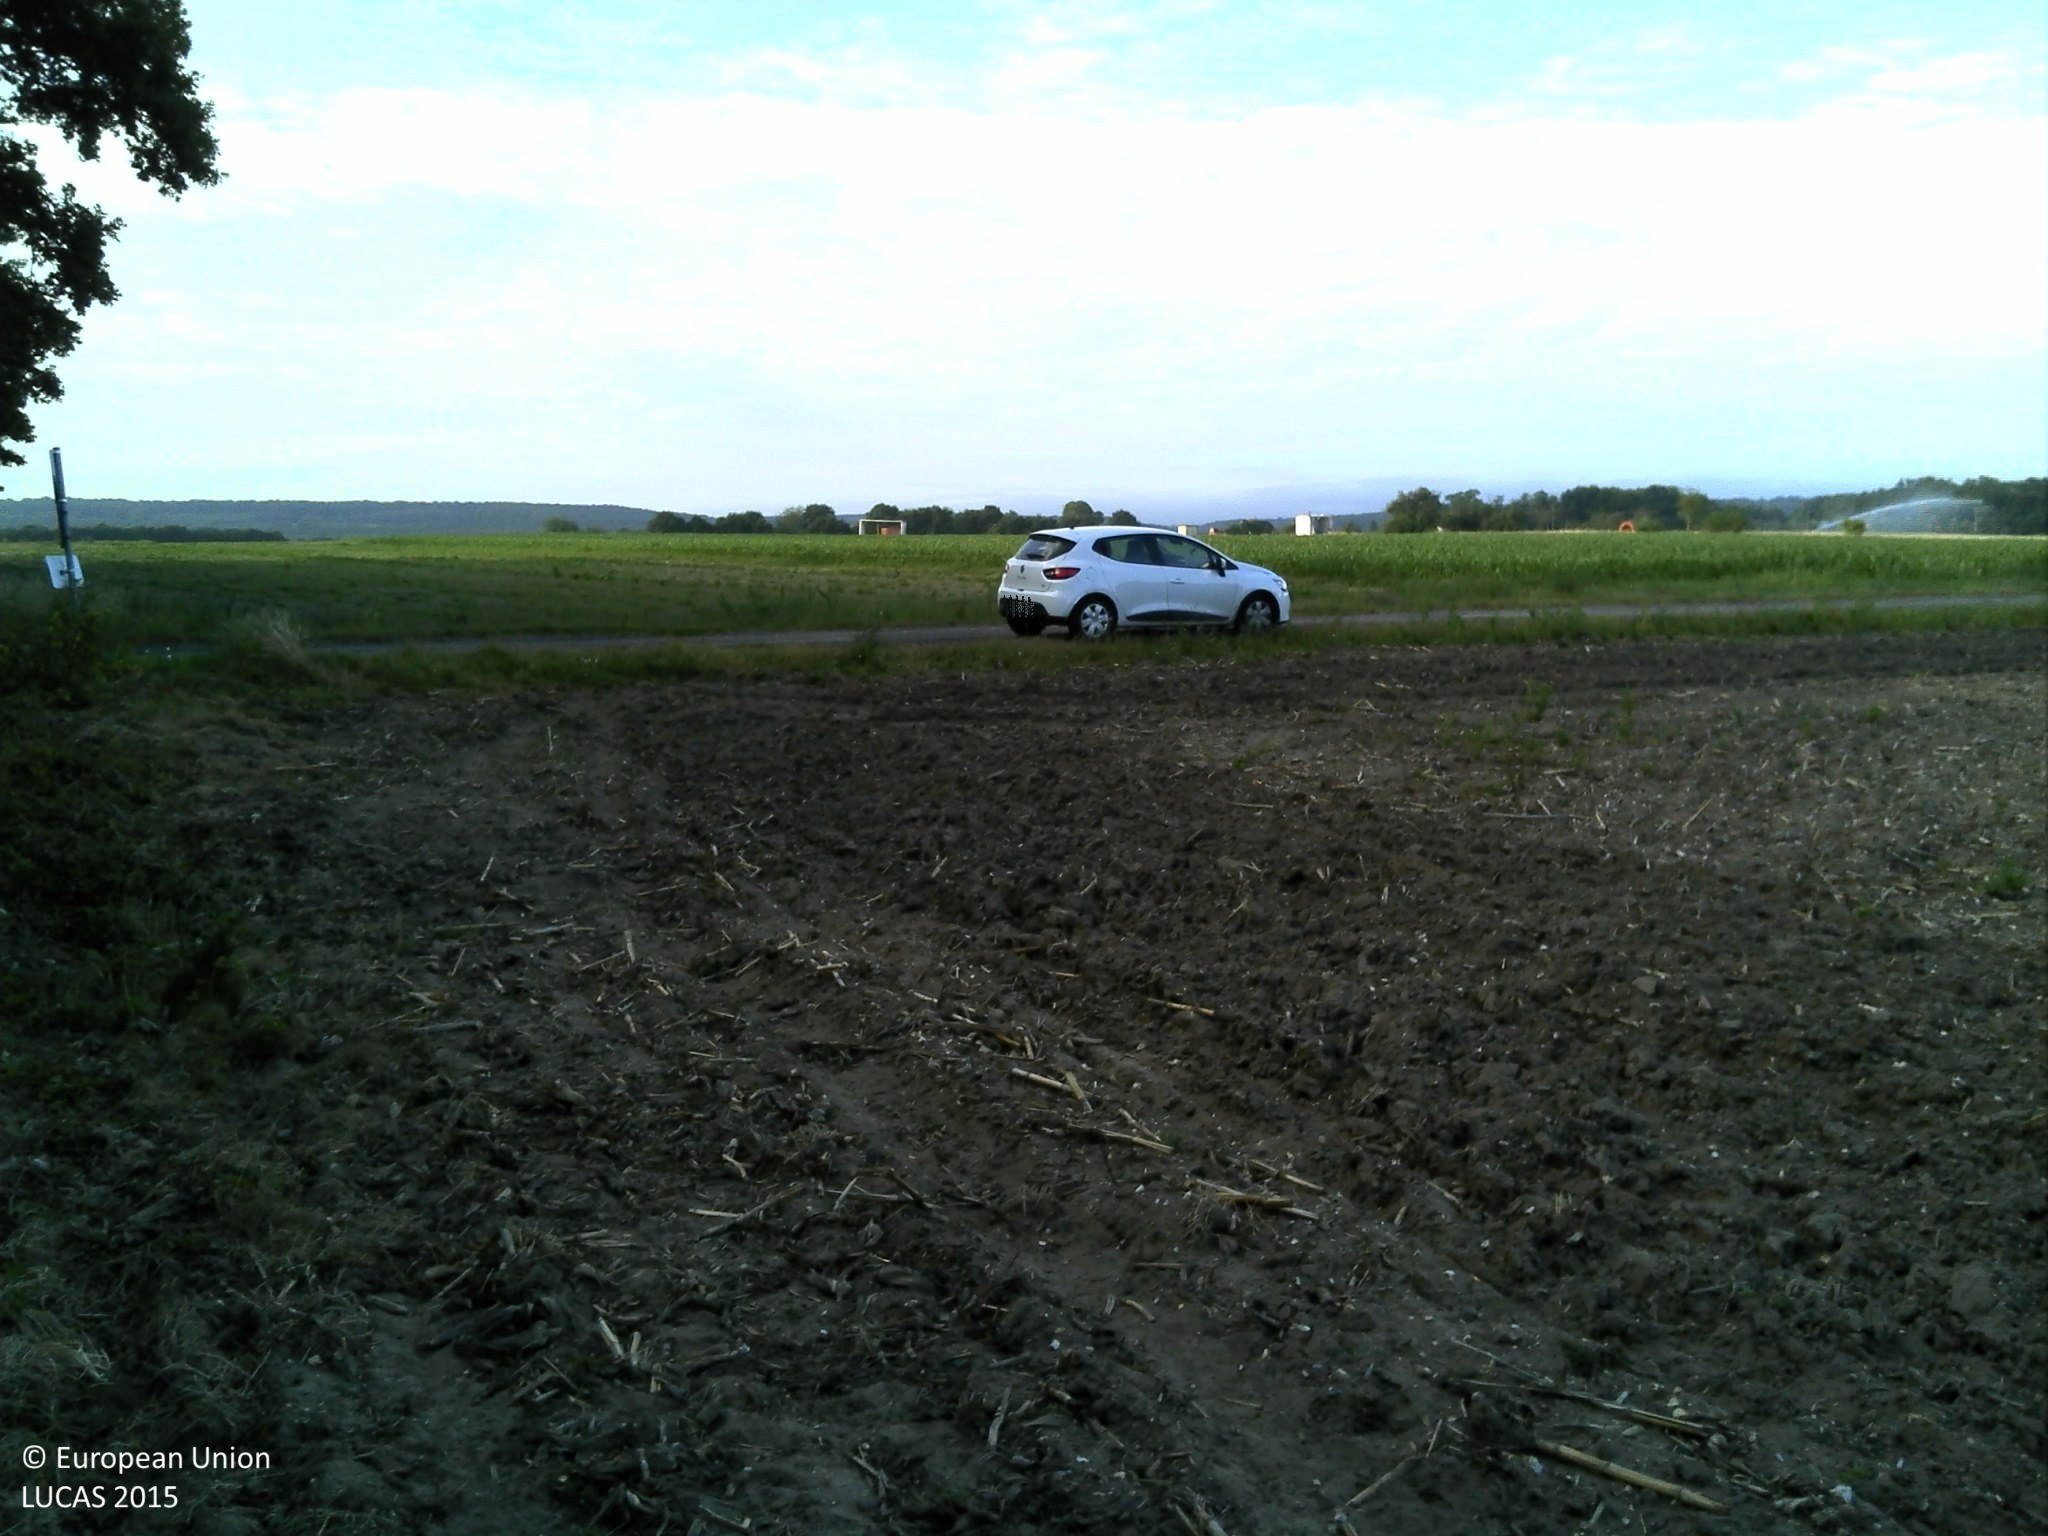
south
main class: Woodland
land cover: Broadleaved woodland
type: acidophilous oak and oak-birch forest
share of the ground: > 75 %
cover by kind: broadleaved forest trees 100 %
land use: Forestry
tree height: > 5 m
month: June
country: FR
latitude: 49.2893
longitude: 1.0554
